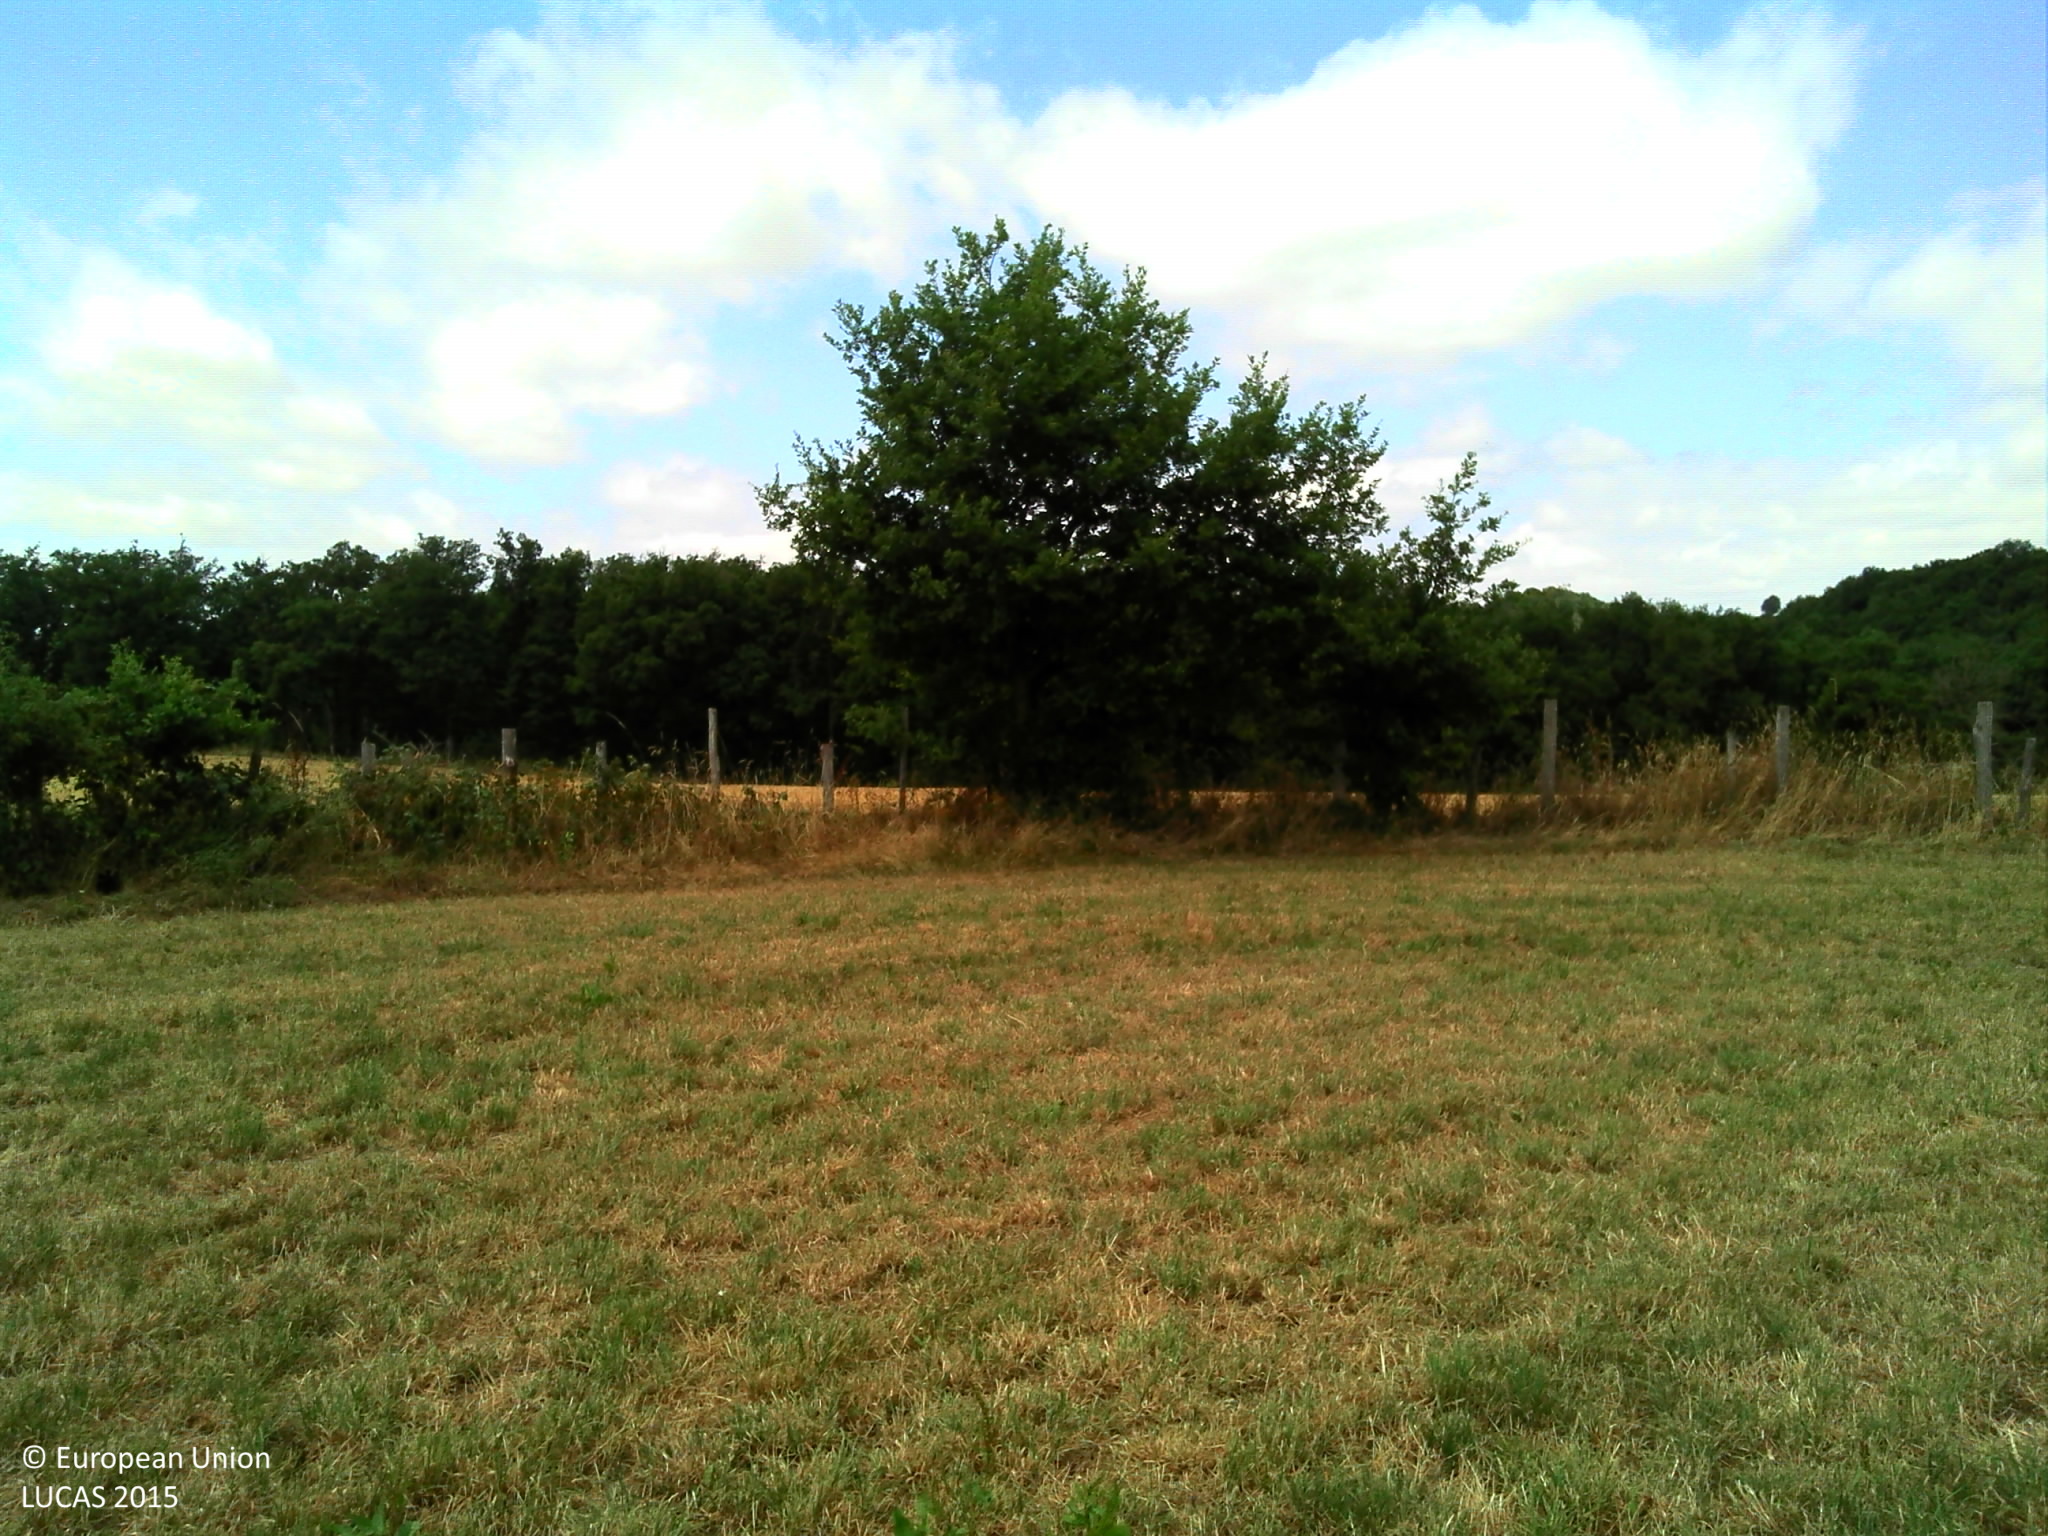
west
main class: Cropland
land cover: Temporary grasslands
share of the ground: > 75 %
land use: Agriculture (excluding fallow land and kitchen gardens)
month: July
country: FR
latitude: 44.1165
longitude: 2.5195
